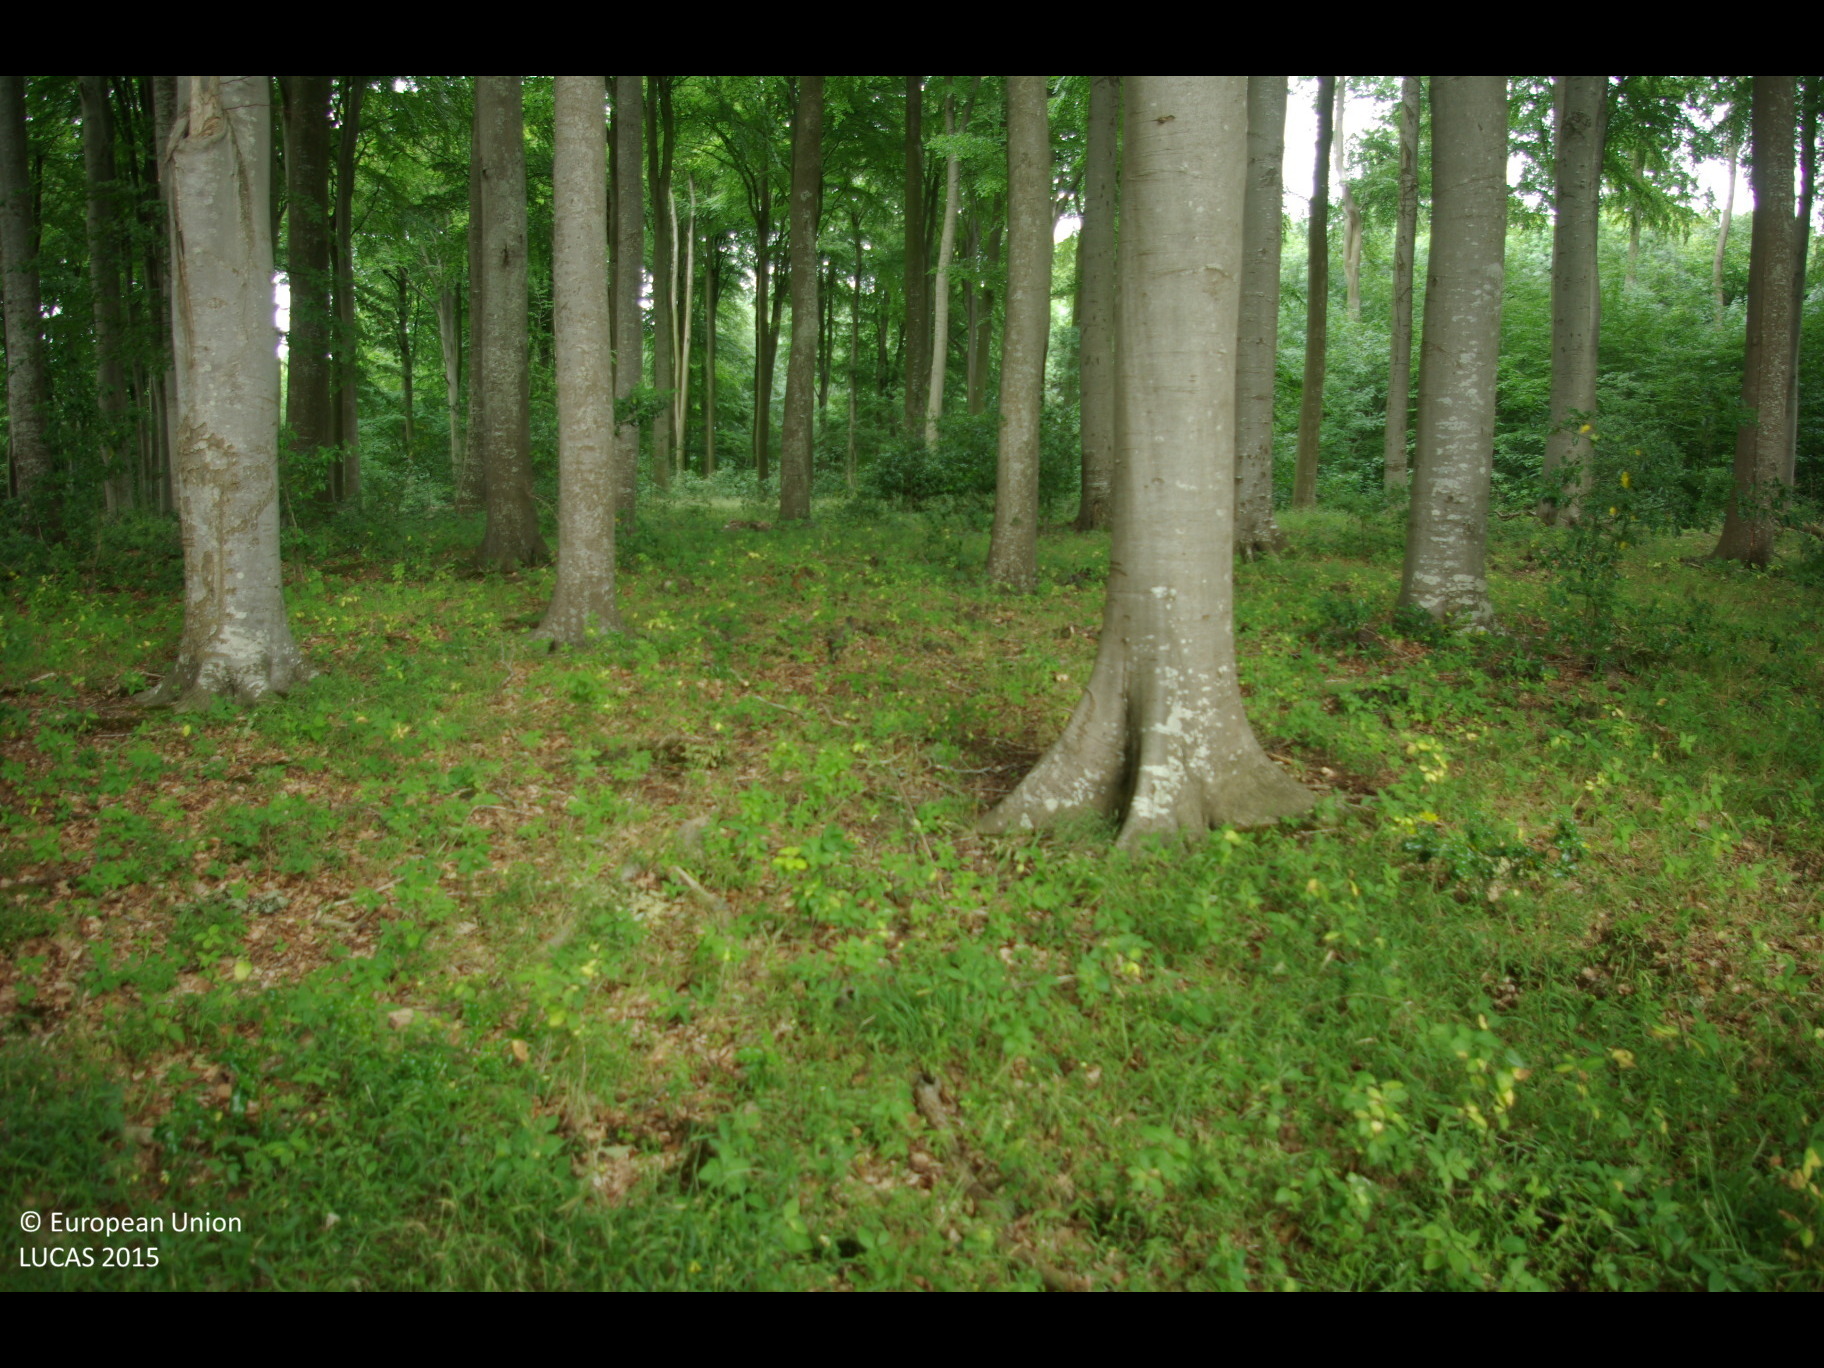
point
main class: Woodland
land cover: Broadleaved woodland
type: beech forest
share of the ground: > 75 %
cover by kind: broadleaved forest trees 90 %, herbaceous plants 10 %
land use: Semi-natural and natural areas not in use
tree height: > 5 m
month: July
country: DE
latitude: 54.6959
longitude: 9.9535
